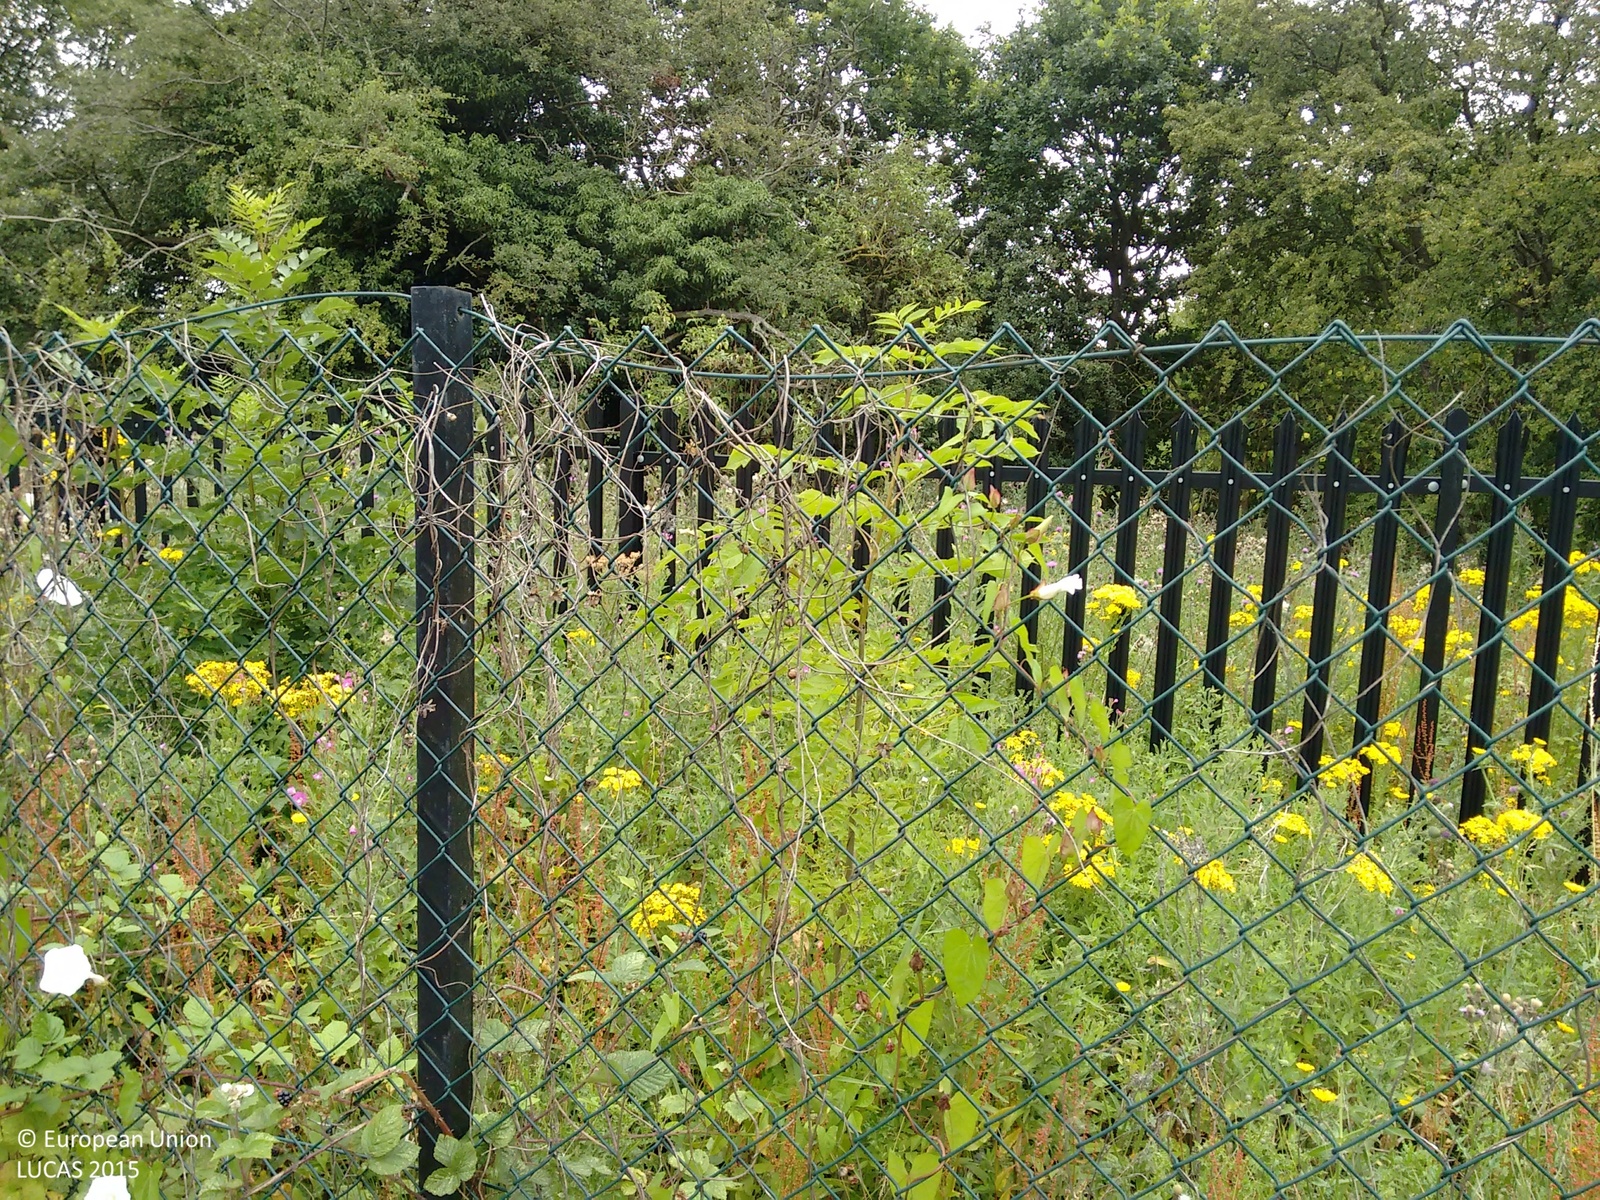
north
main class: Woodland
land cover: Broadleaved woodland
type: mesophytic deciduous forest
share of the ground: 25 - 50 %
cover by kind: broadleaved forest trees 50 %, shrubs 40 %, herbaceous plants 10 %
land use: Abandoned areas
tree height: > 5 m
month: July
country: GB
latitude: 51.6424
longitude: -0.2522
